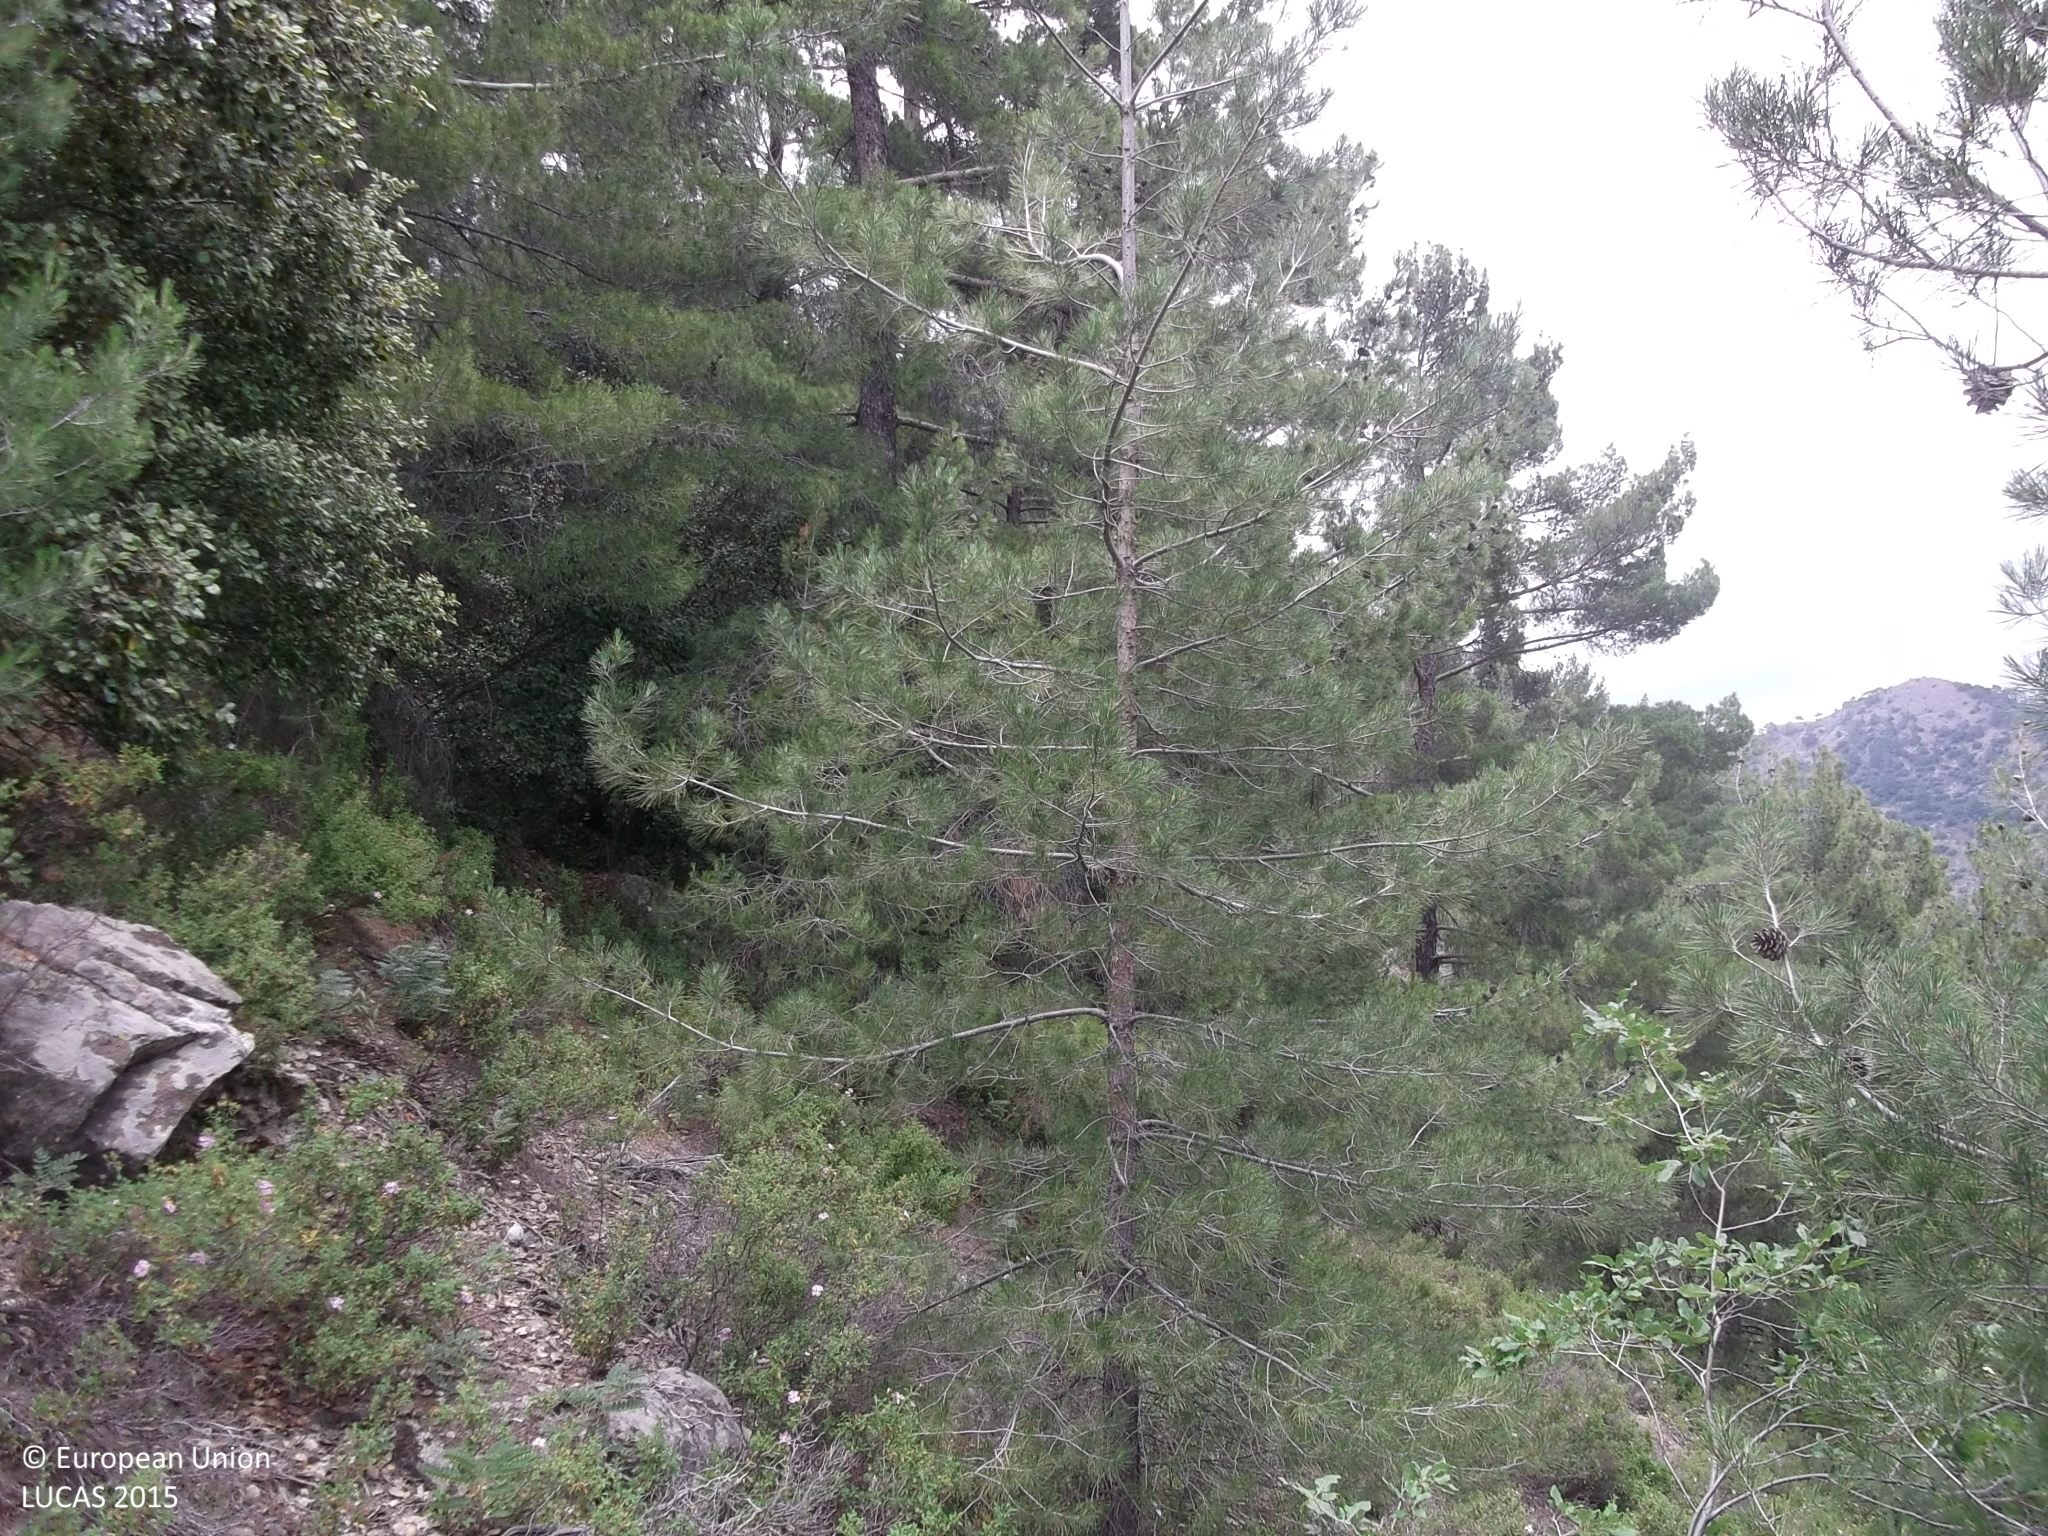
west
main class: Woodland
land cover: Pine dominated coniferous woodland
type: coniferous forest of the mediterranean region
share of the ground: > 75 %
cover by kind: coniferous forest trees 80 %, shrubs 10 %, consolidated bare surface 5 %, unconsolidated bare surface 5 %
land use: Semi-natural and natural areas not in use
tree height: > 5 m
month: June
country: CY
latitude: 34.9610
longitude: 33.0068
